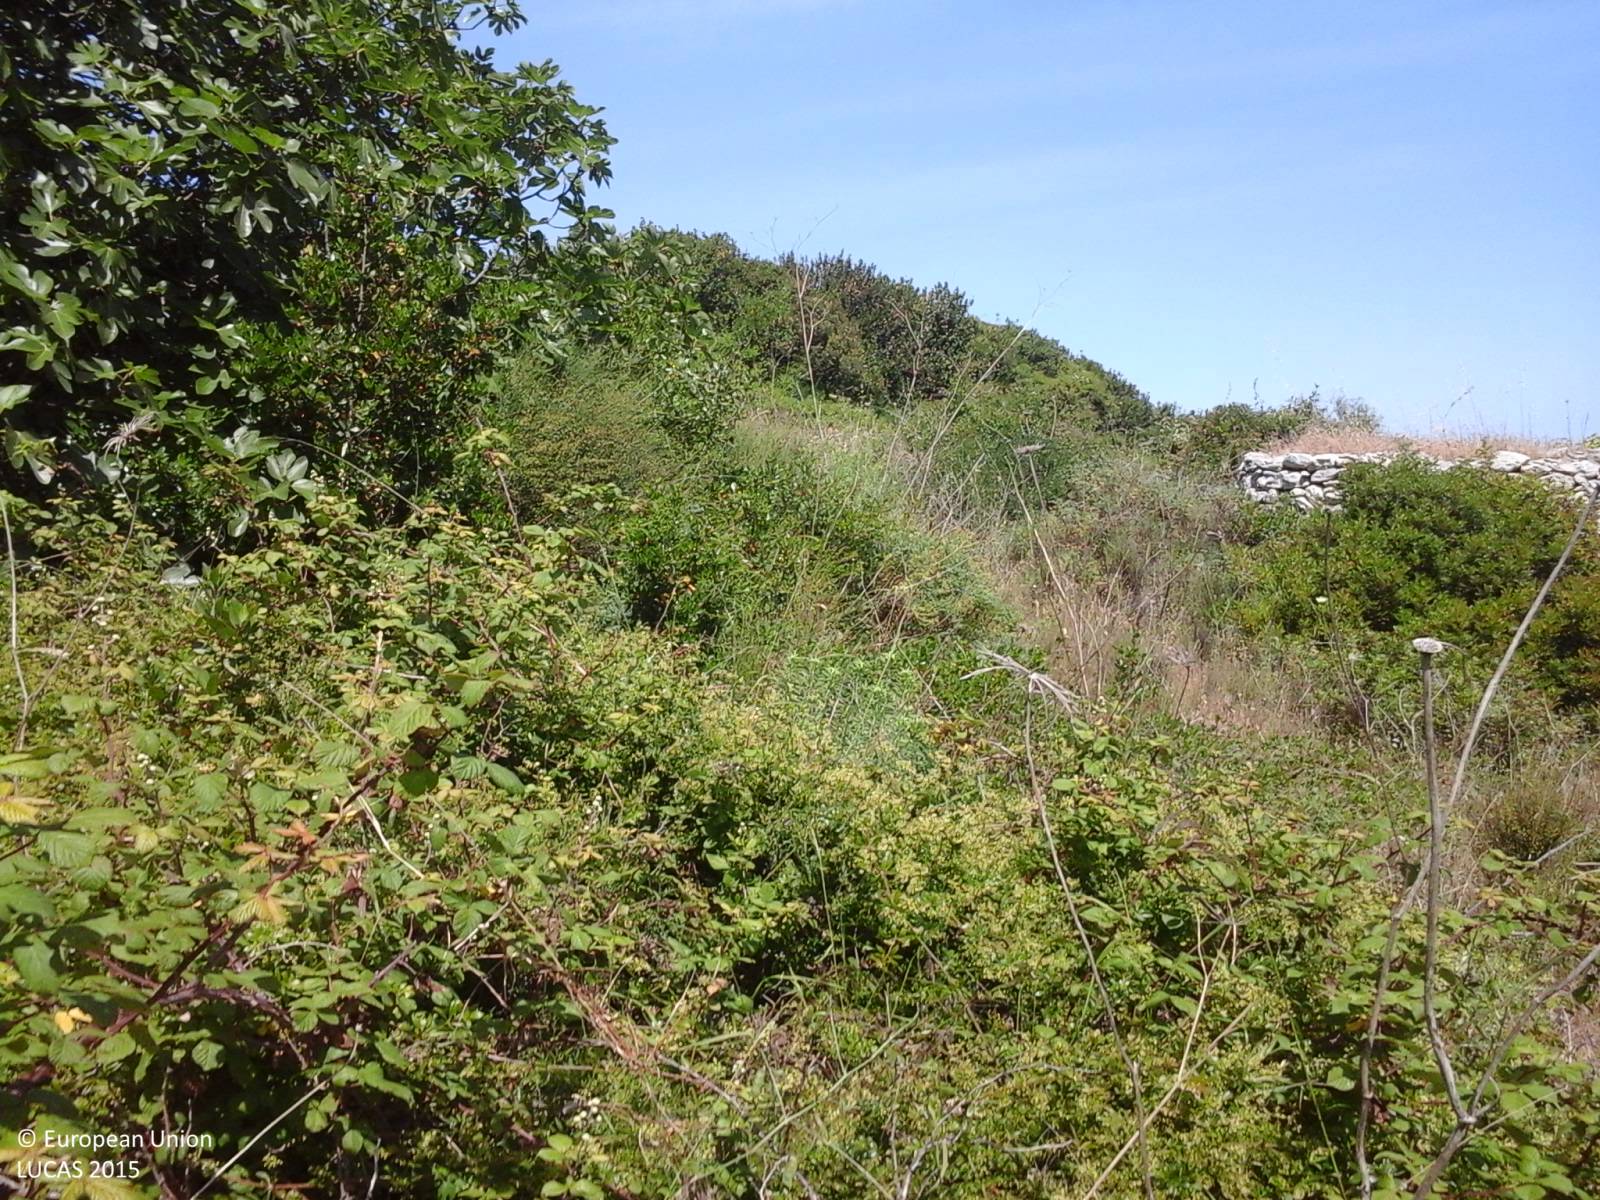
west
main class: Shrubland
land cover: Shrubland without tree cover
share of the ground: > 75 %
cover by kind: herbaceous plants 55 %, shrubs 45 %
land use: Semi-natural and natural areas not in use
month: May
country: IT
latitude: 40.7822
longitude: 8.5966
